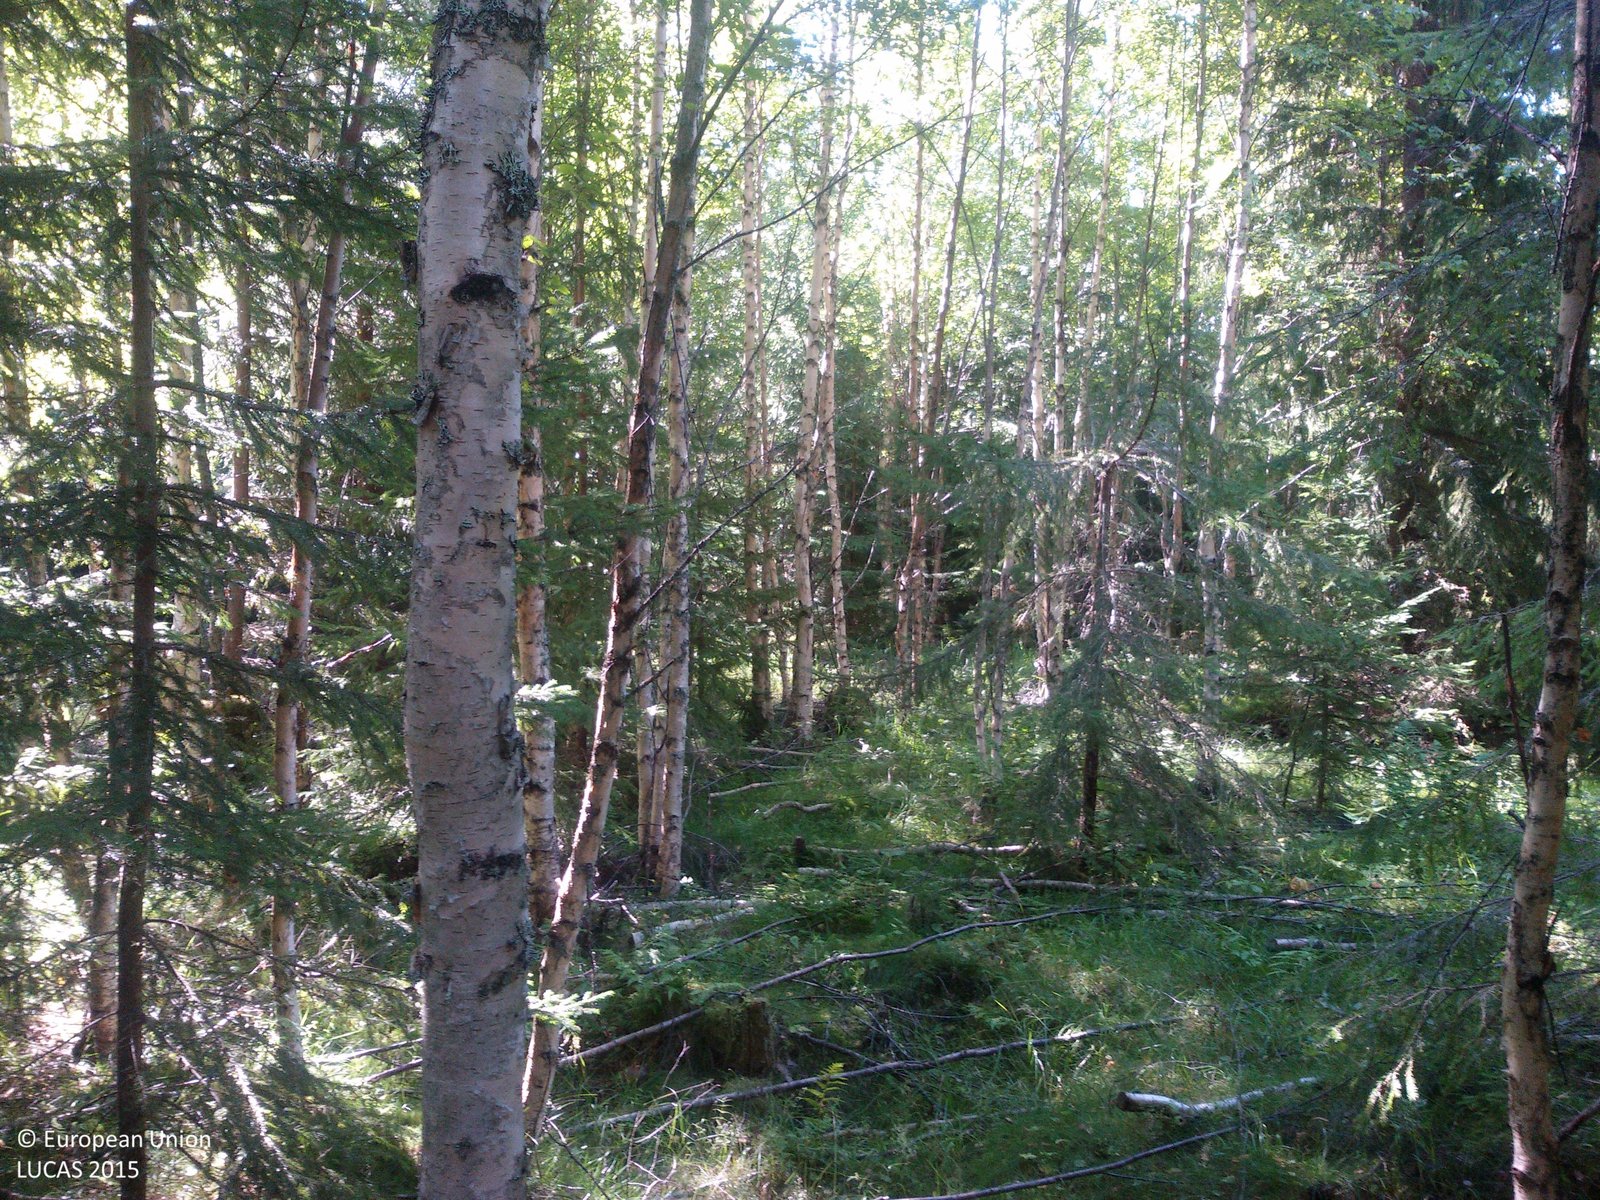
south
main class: Woodland
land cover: Spruce dominated mixed woodland
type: boreal forest
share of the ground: > 75 %
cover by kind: coniferous forest trees 50 %, broadleaved forest trees 30 %, shrubs 10 %, lichens and mosses 10 %
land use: Forestry
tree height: > 5 m
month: August
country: SE
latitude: 60.7016
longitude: 16.4543
